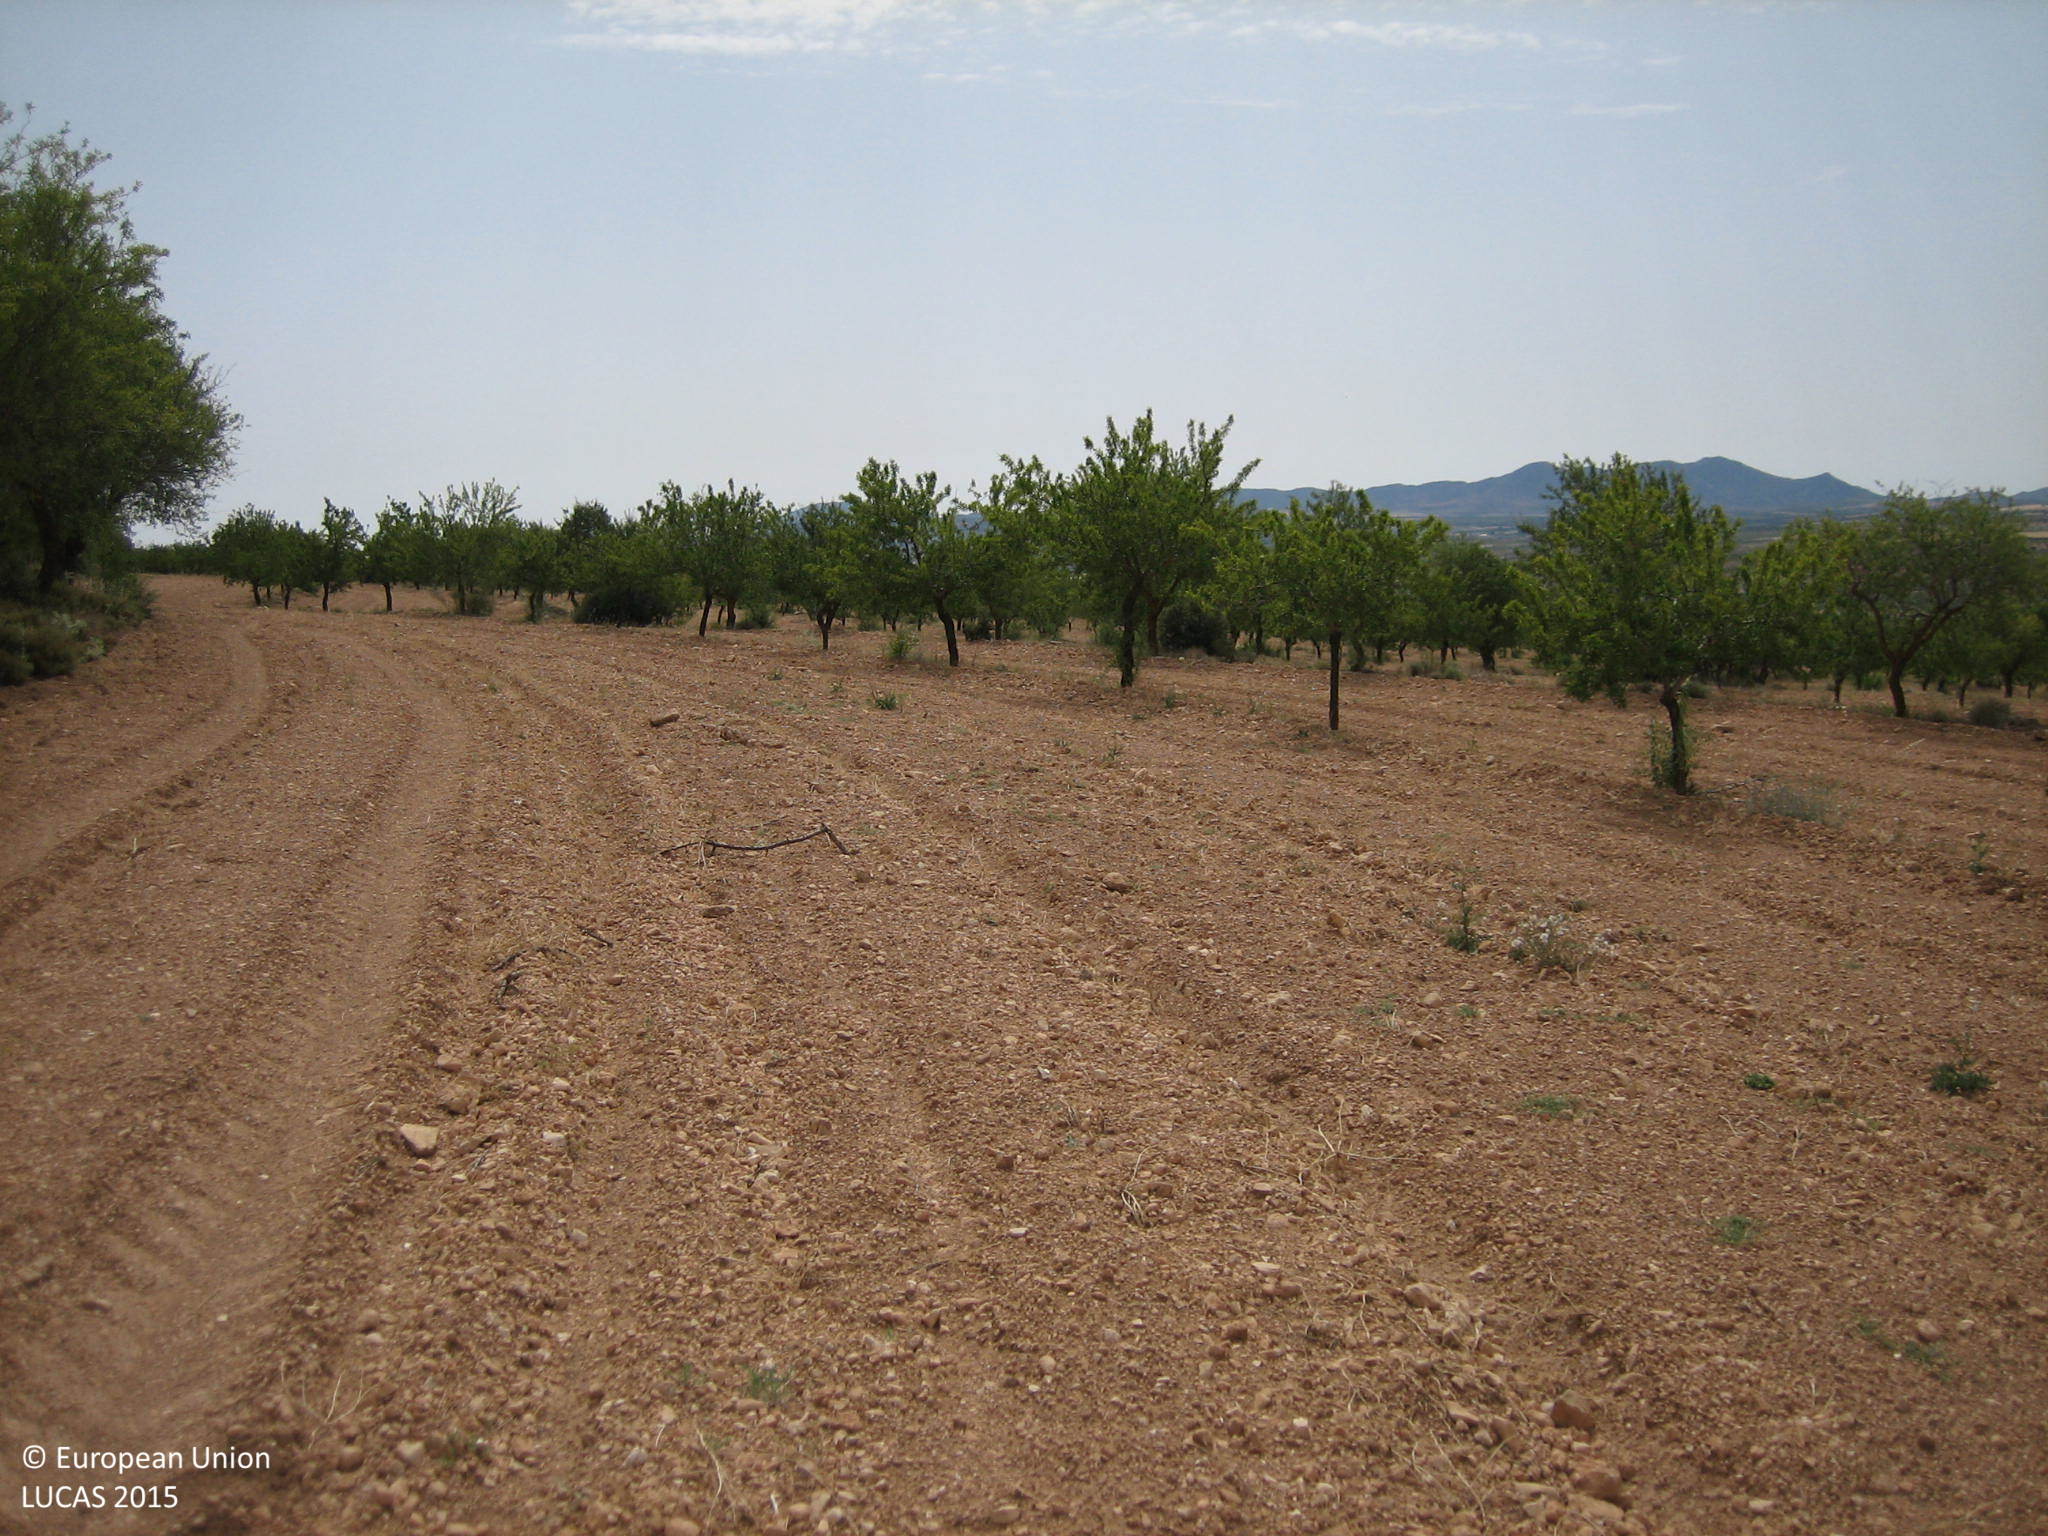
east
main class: Cropland
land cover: Nuts trees
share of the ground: < 10 %
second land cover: Other bare soil
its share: > 75 %
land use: Agriculture (excluding fallow land and kitchen gardens)
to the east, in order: Nuts trees; Other bare soil
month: July
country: ES
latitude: 37.6027
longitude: -2.3206
